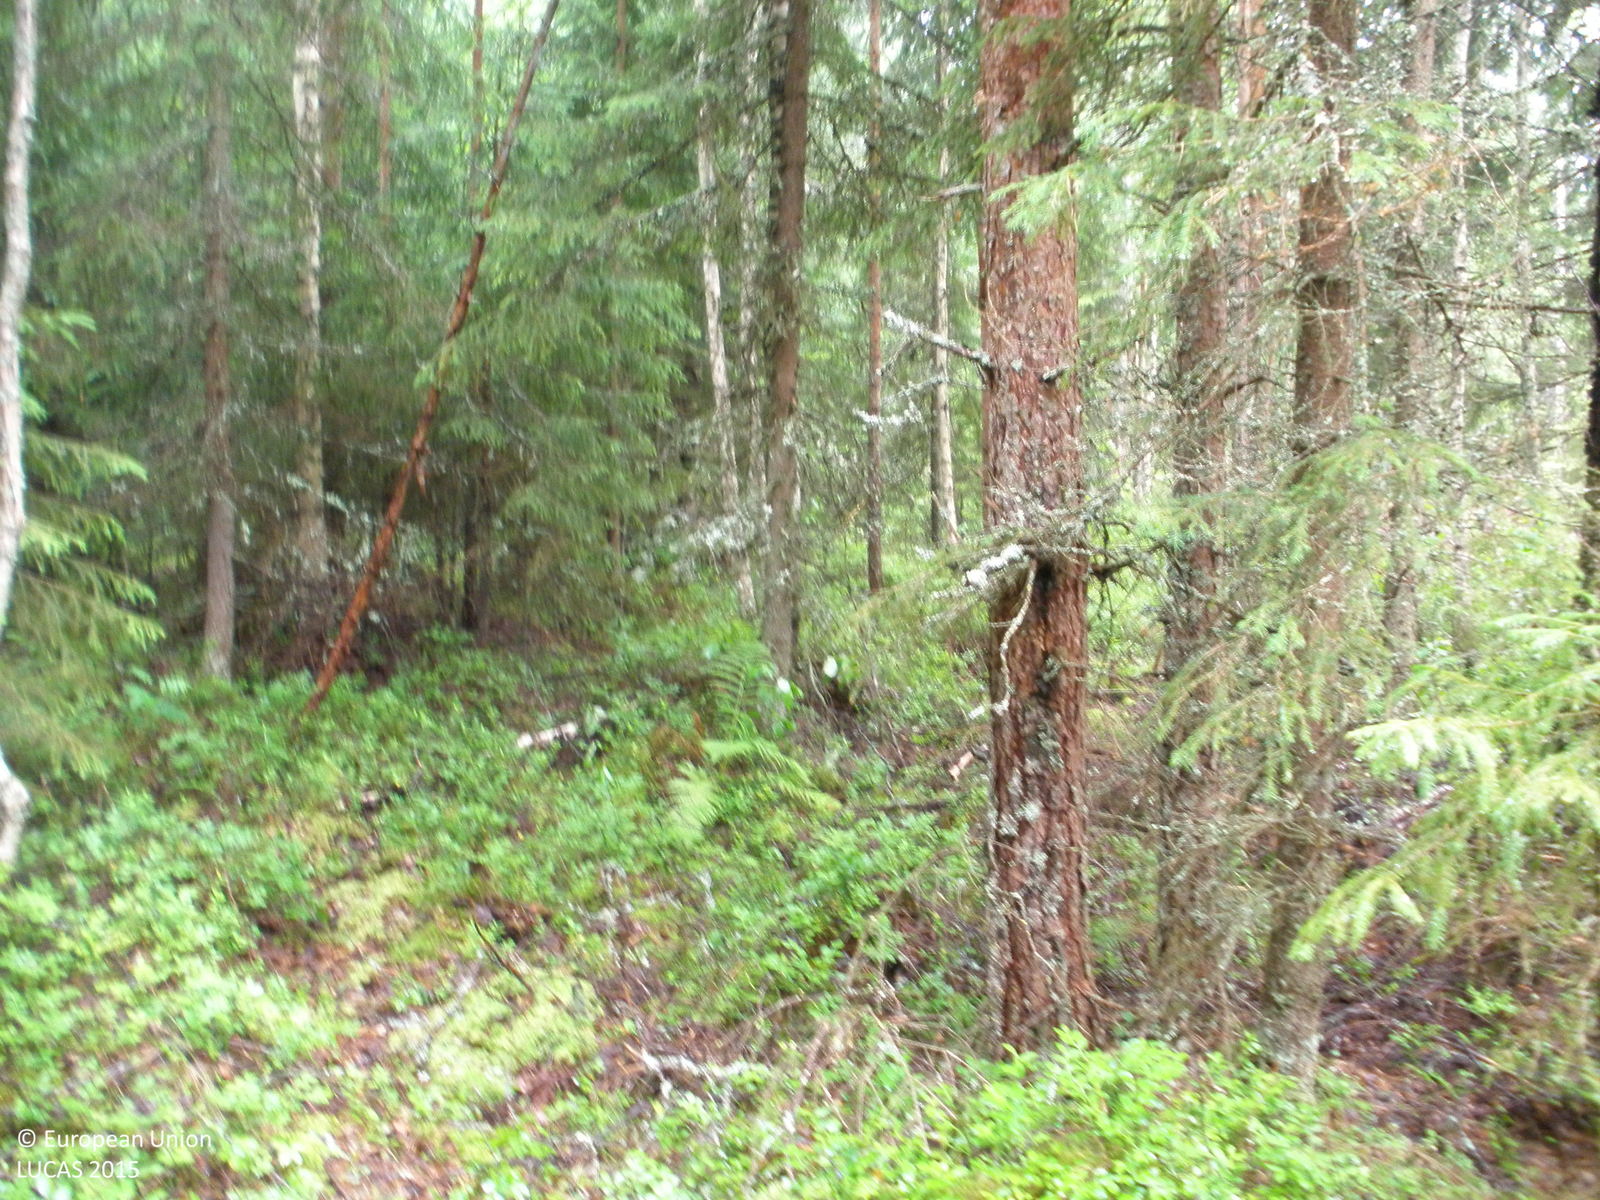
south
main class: Woodland
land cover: Spruce dominated mixed woodland
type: boreal forest
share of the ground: > 75 %
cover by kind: coniferous forest trees 40 %, broadleaved forest trees 35 %, herbaceous plants 15 %, lichens and mosses 5 %
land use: Forestry
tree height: > 5 m
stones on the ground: < 10 %
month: July
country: FI
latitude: 61.3956
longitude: 23.6961
